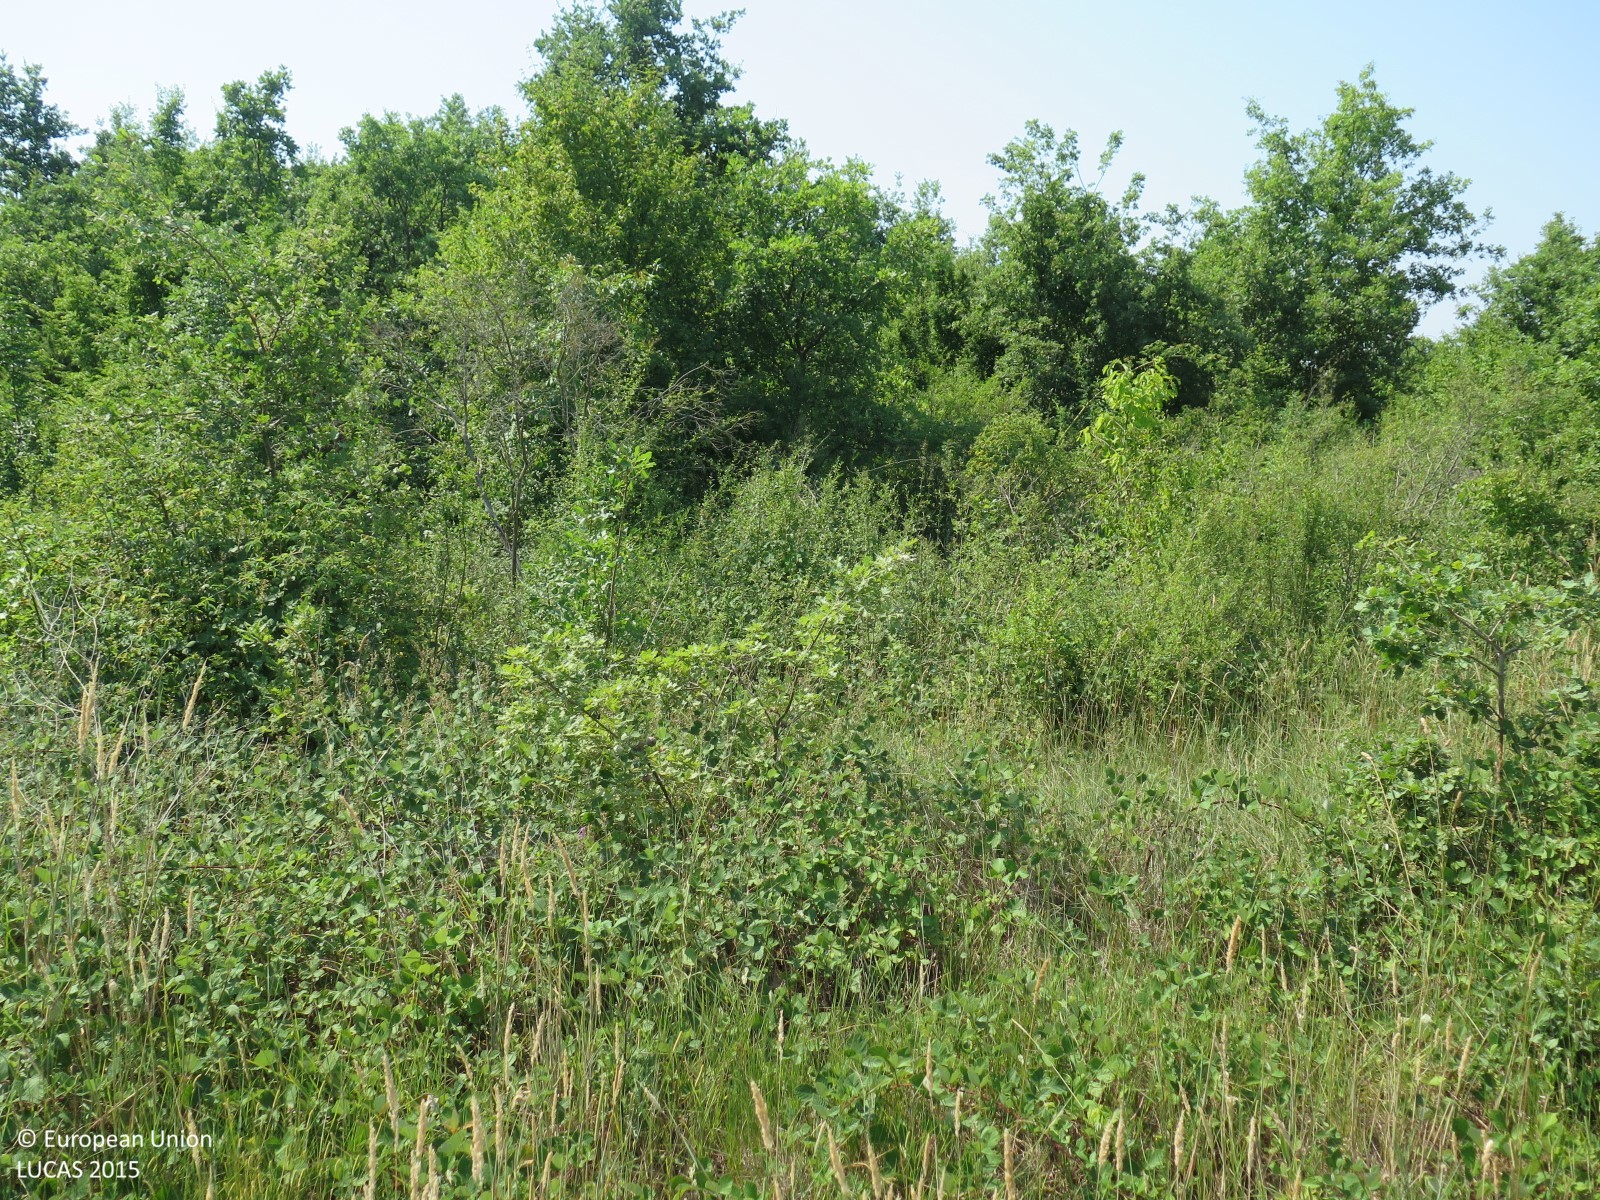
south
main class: Grassland
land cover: Grassland with sparse tree/shrub cover
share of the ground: > 75 %
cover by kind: herbaceous plants 90 %, broadleaved forest trees 5 %, shrubs 5 %
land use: Semi-natural and natural areas not in use
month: July
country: HR
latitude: 45.2788
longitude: 13.6536
